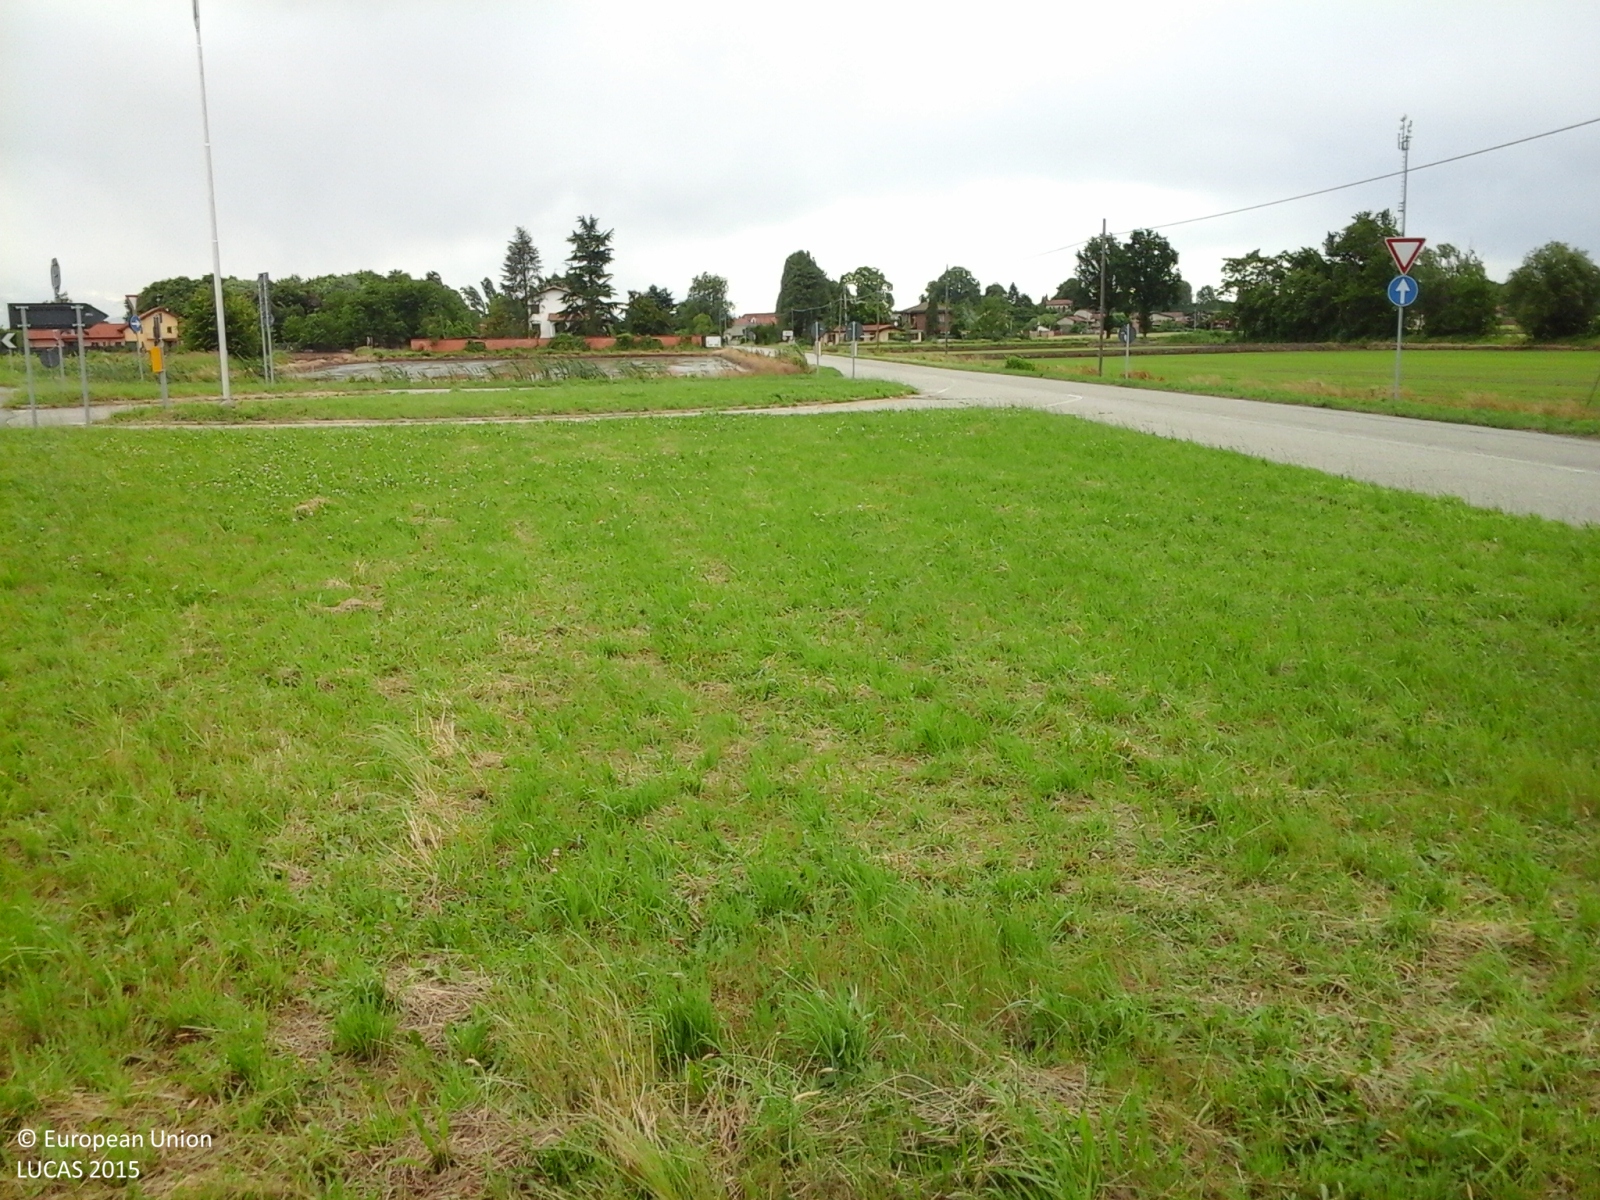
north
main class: Grassland
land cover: Grassland without tree/shrub cover
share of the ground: > 75 %
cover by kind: herbaceous plants 85 %, consolidated bare surface 15 %
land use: Road transport
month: May
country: IT
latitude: 45.4199
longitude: 8.3797
